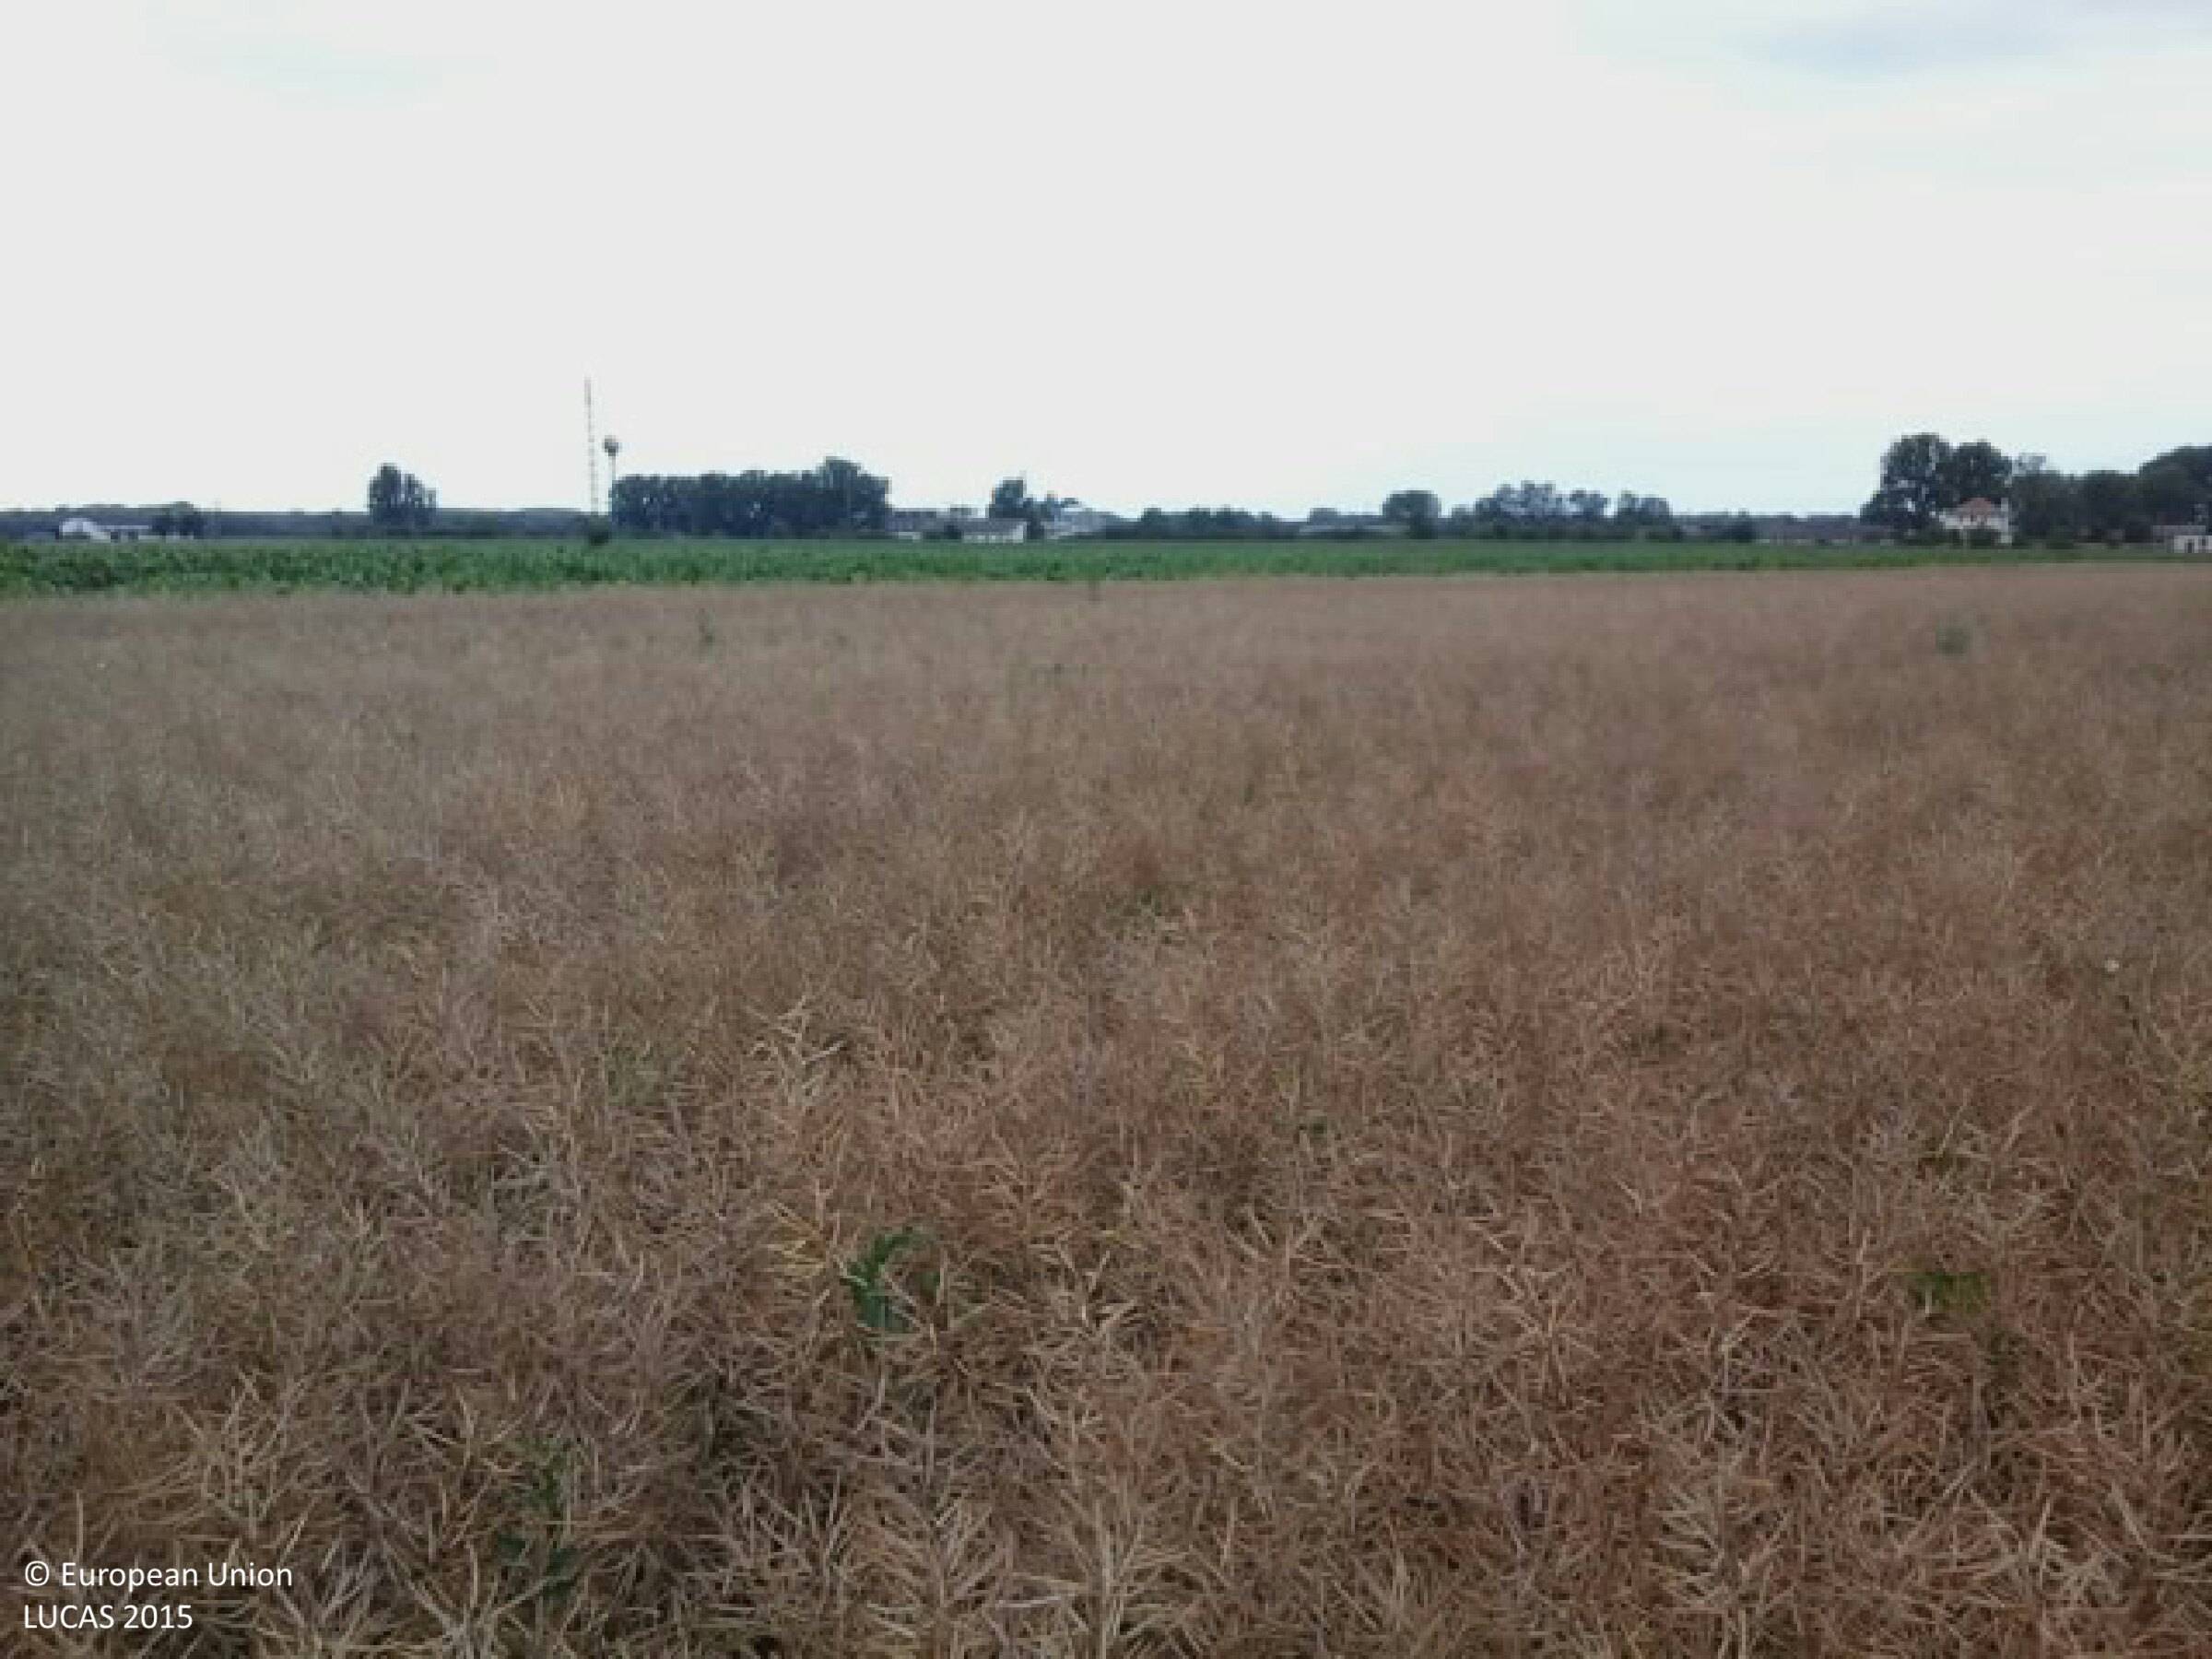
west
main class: Cropland
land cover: Rape and turnip rape
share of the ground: > 75 %
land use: Agriculture (excluding fallow land and kitchen gardens)
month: June
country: HU
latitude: 46.2115
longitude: 18.9428
